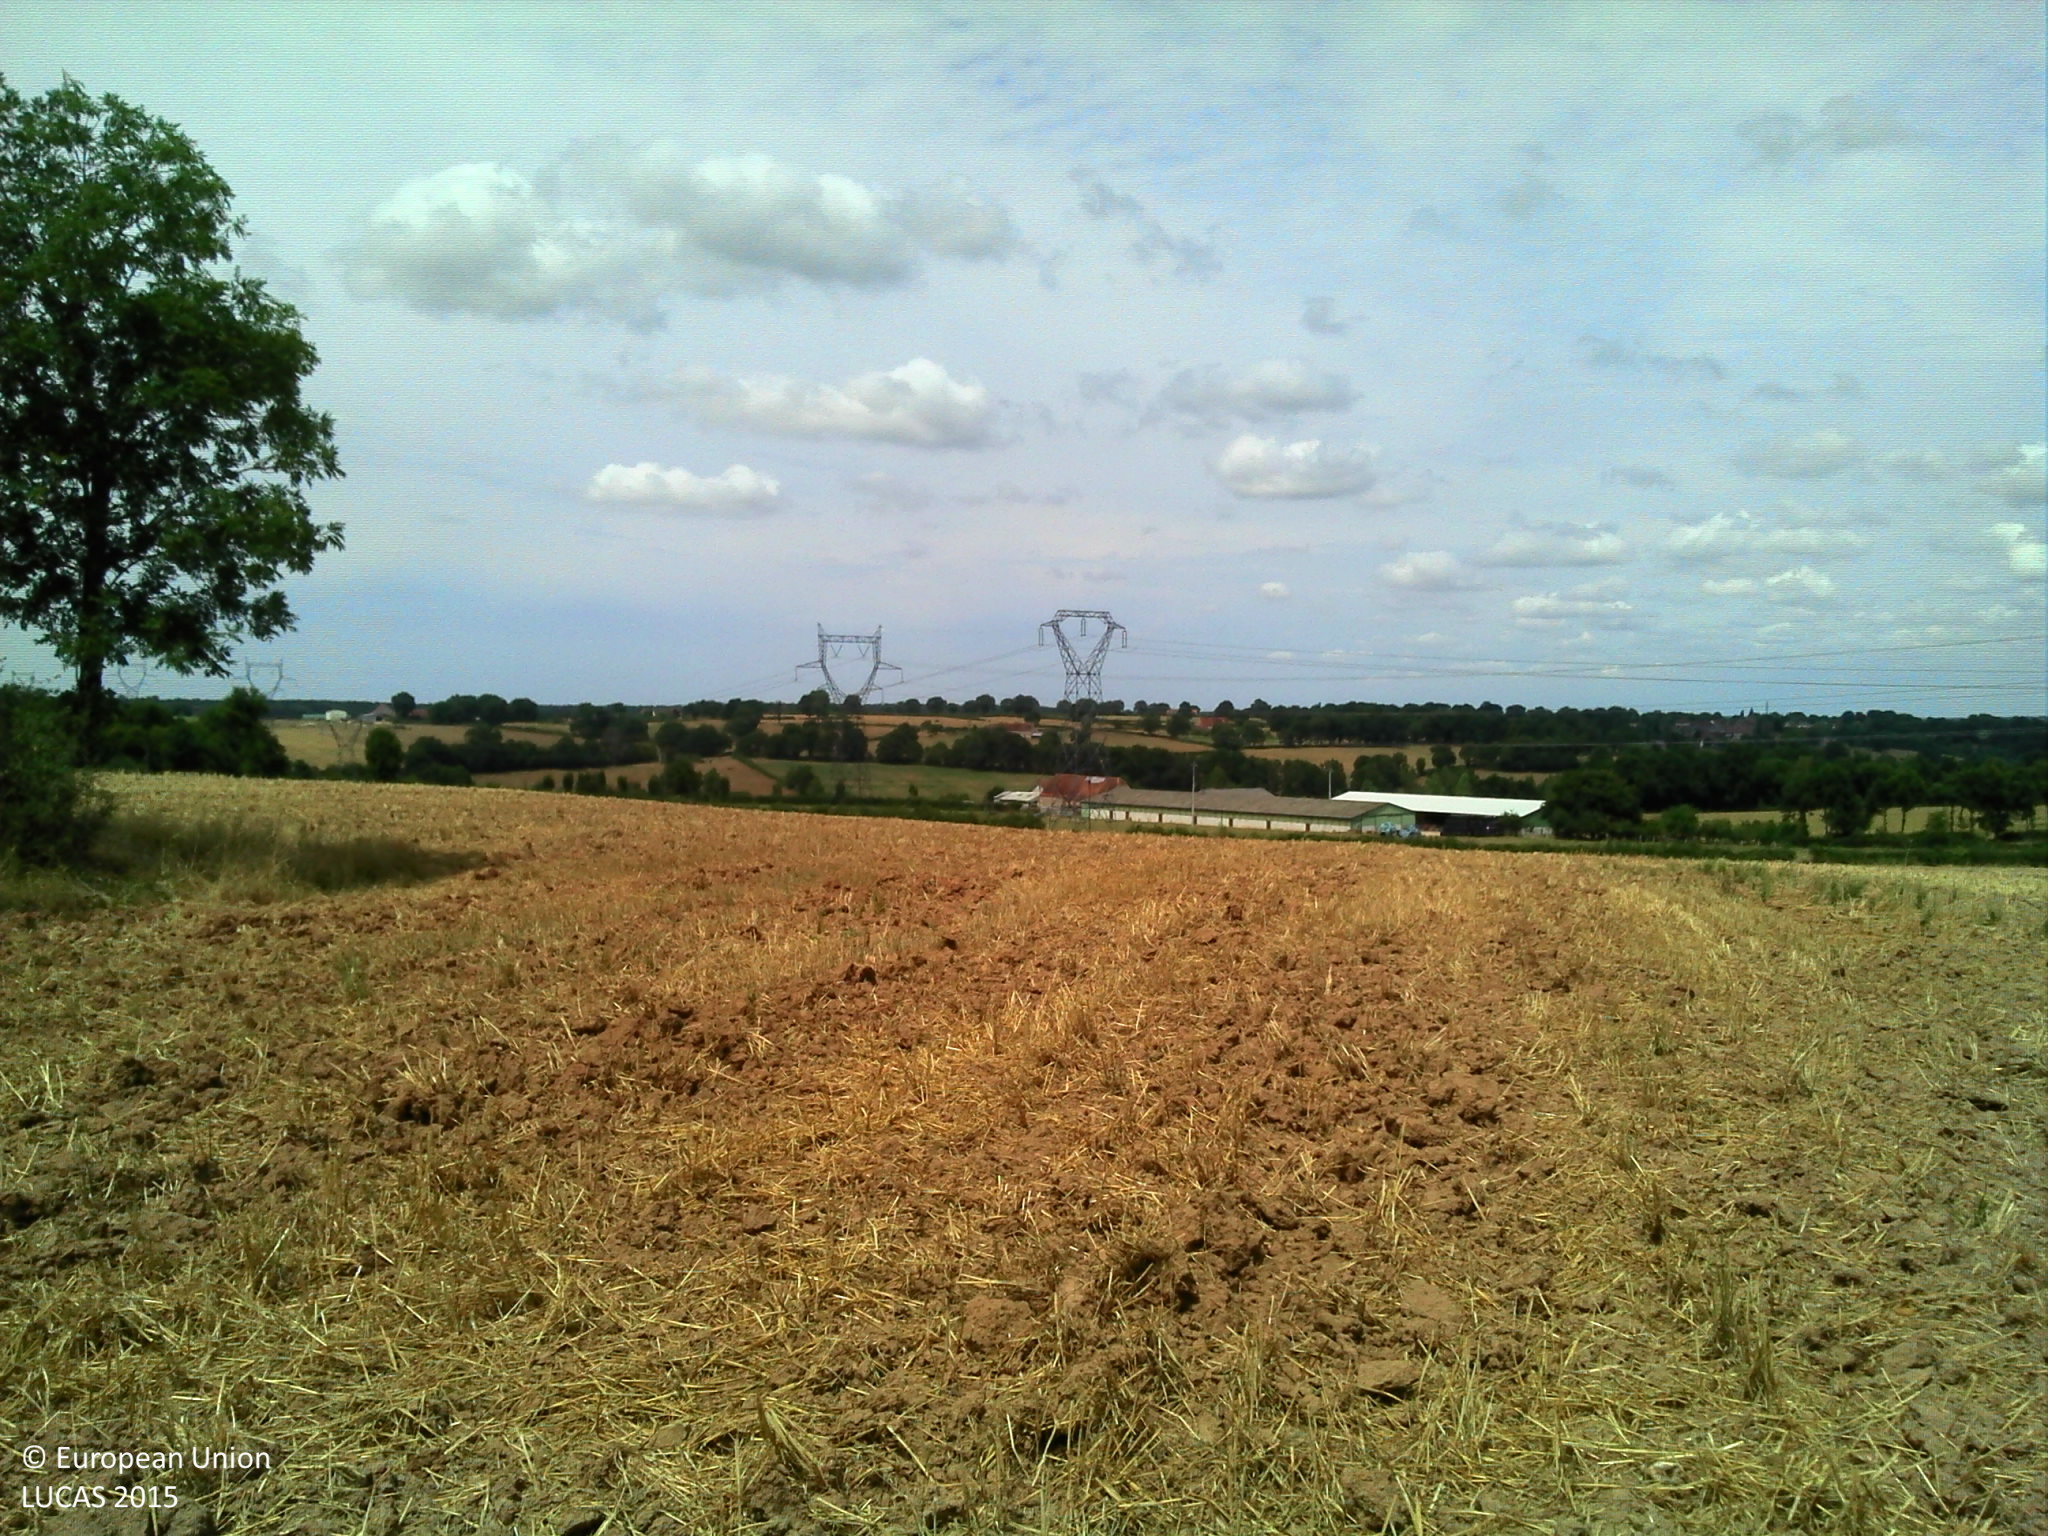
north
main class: Cropland
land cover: Barley
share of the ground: > 75 %
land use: Agriculture (excluding fallow land and kitchen gardens)
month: July
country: FR
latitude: 46.6071
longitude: 2.9595
